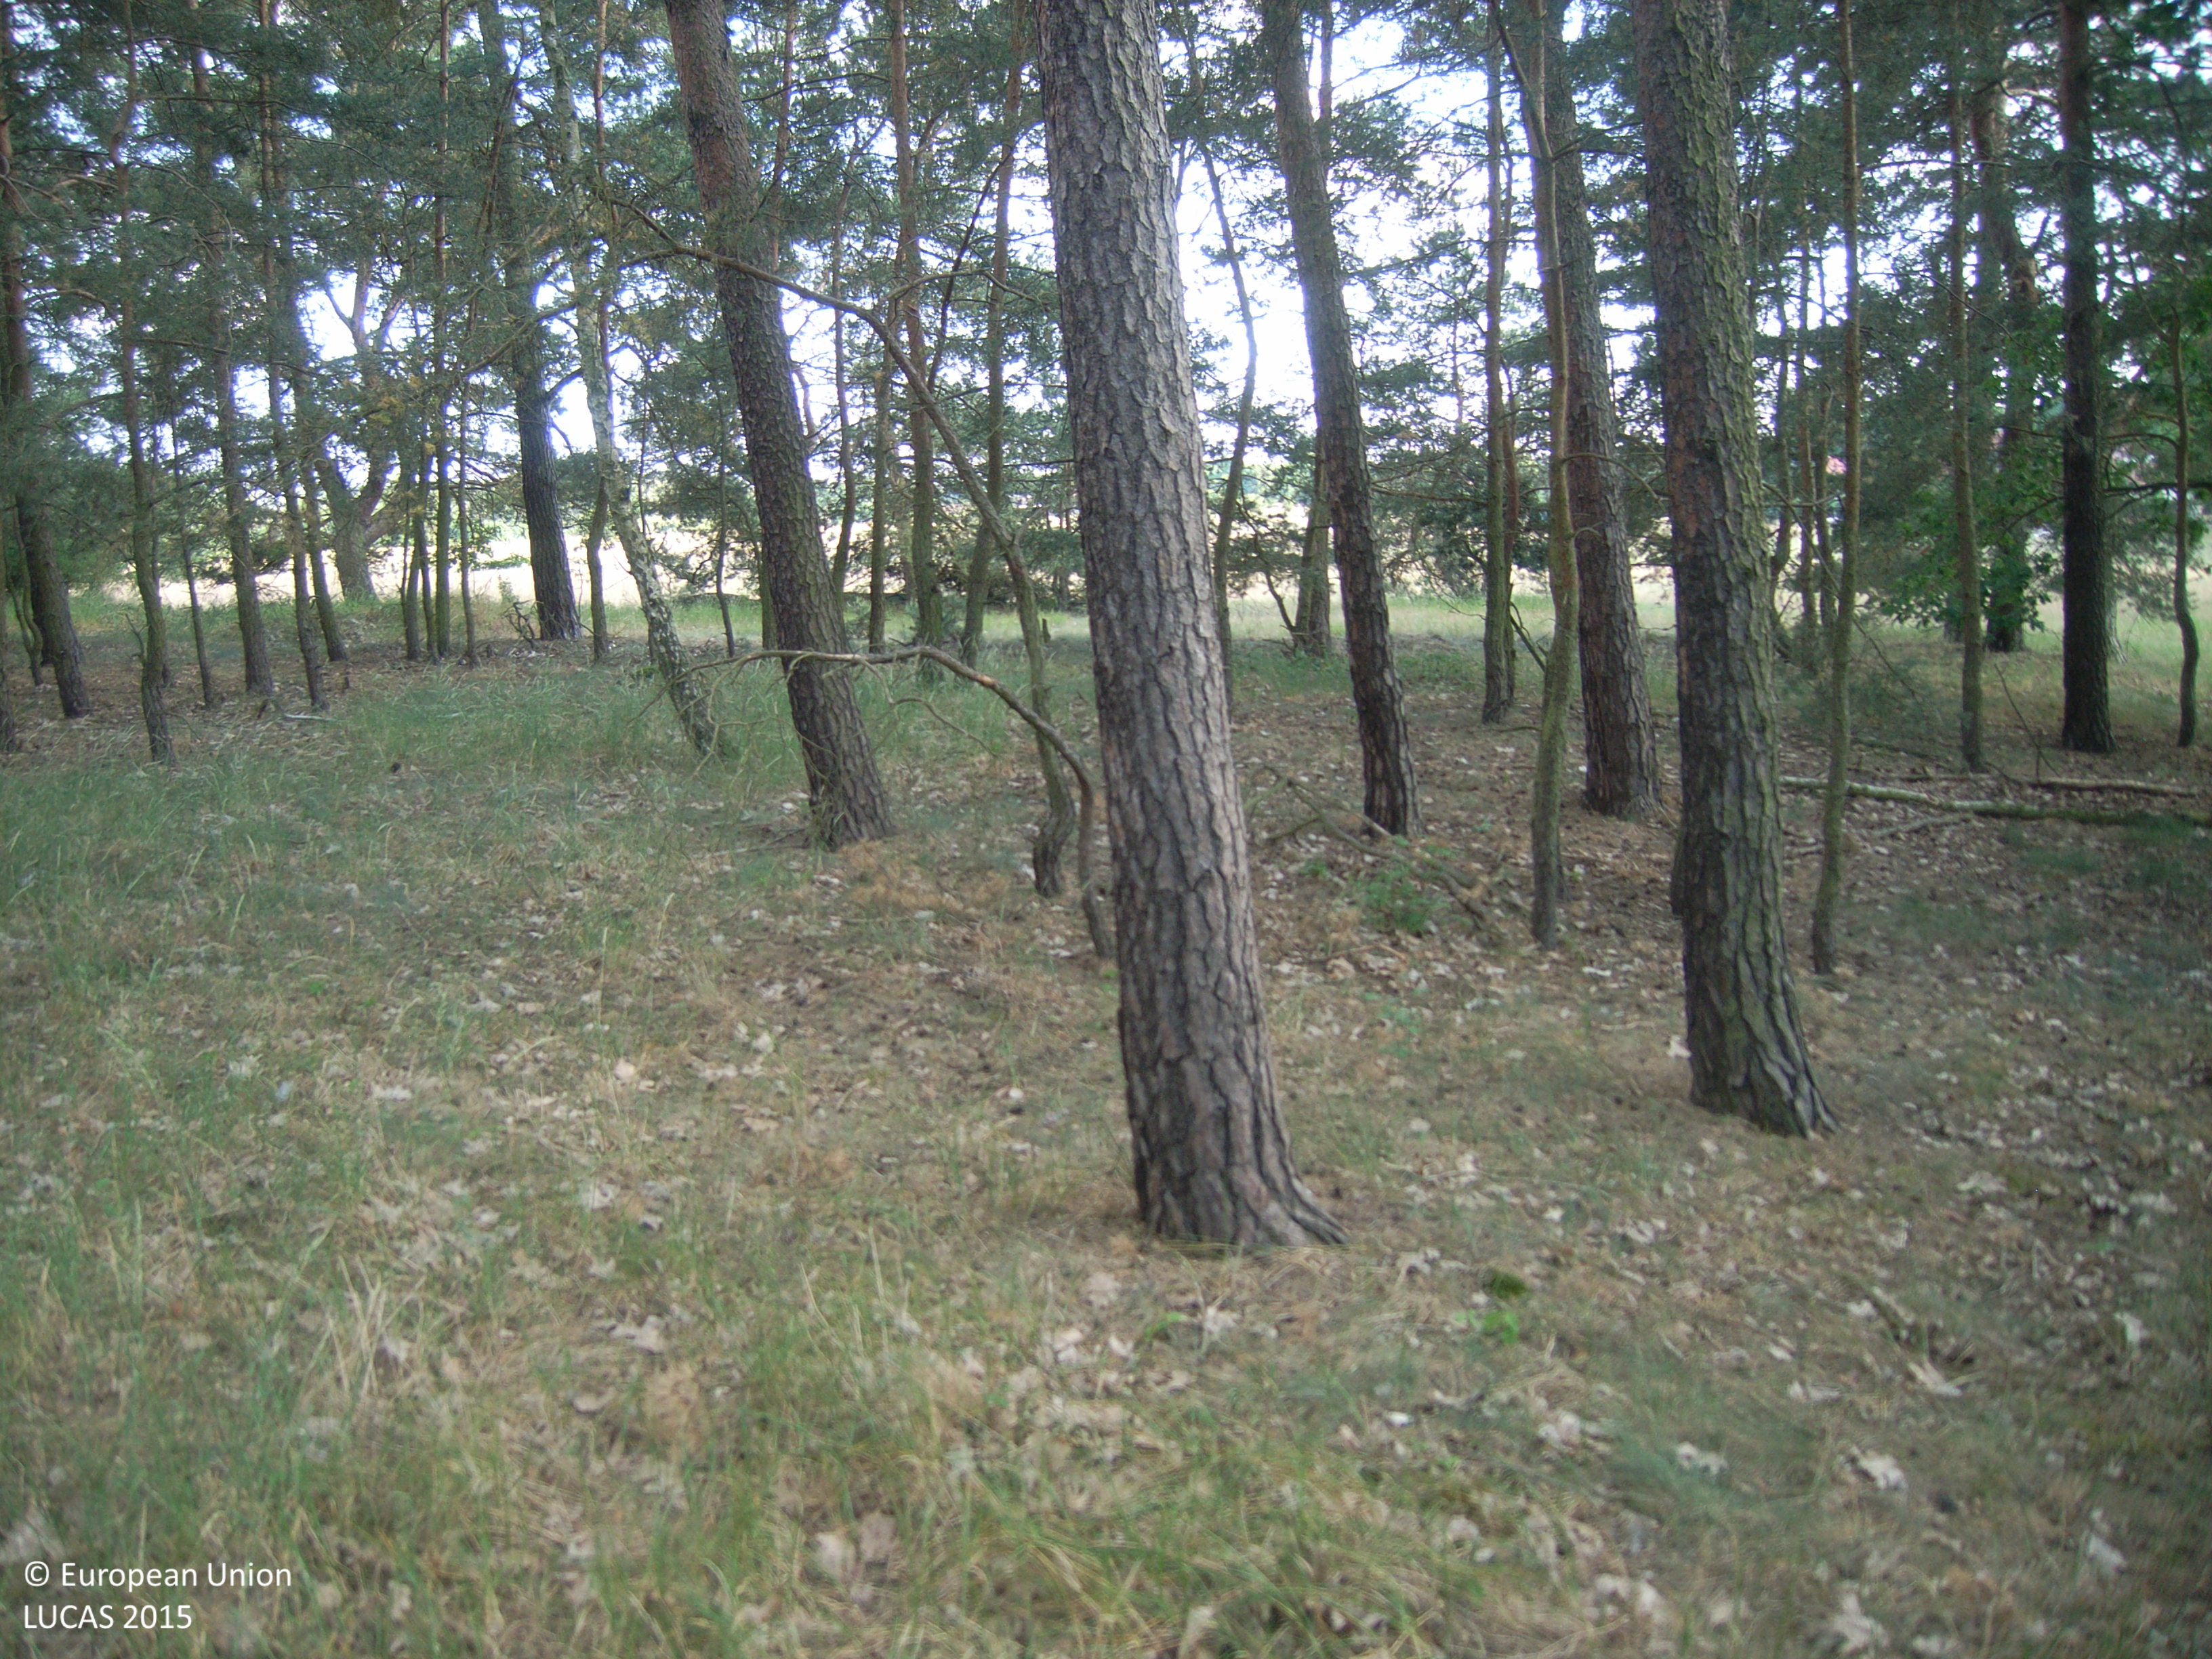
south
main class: Woodland
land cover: Pine dominated coniferous woodland
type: hemiboreal forest and nemoral coniferous forest and mixed broadleaved-coniferous forest
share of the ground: > 75 %
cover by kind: coniferous forest trees 95 %, herbaceous plants 5 %
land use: Forestry
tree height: > 5 m
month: June
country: DE
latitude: 52.0727
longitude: 14.1007
